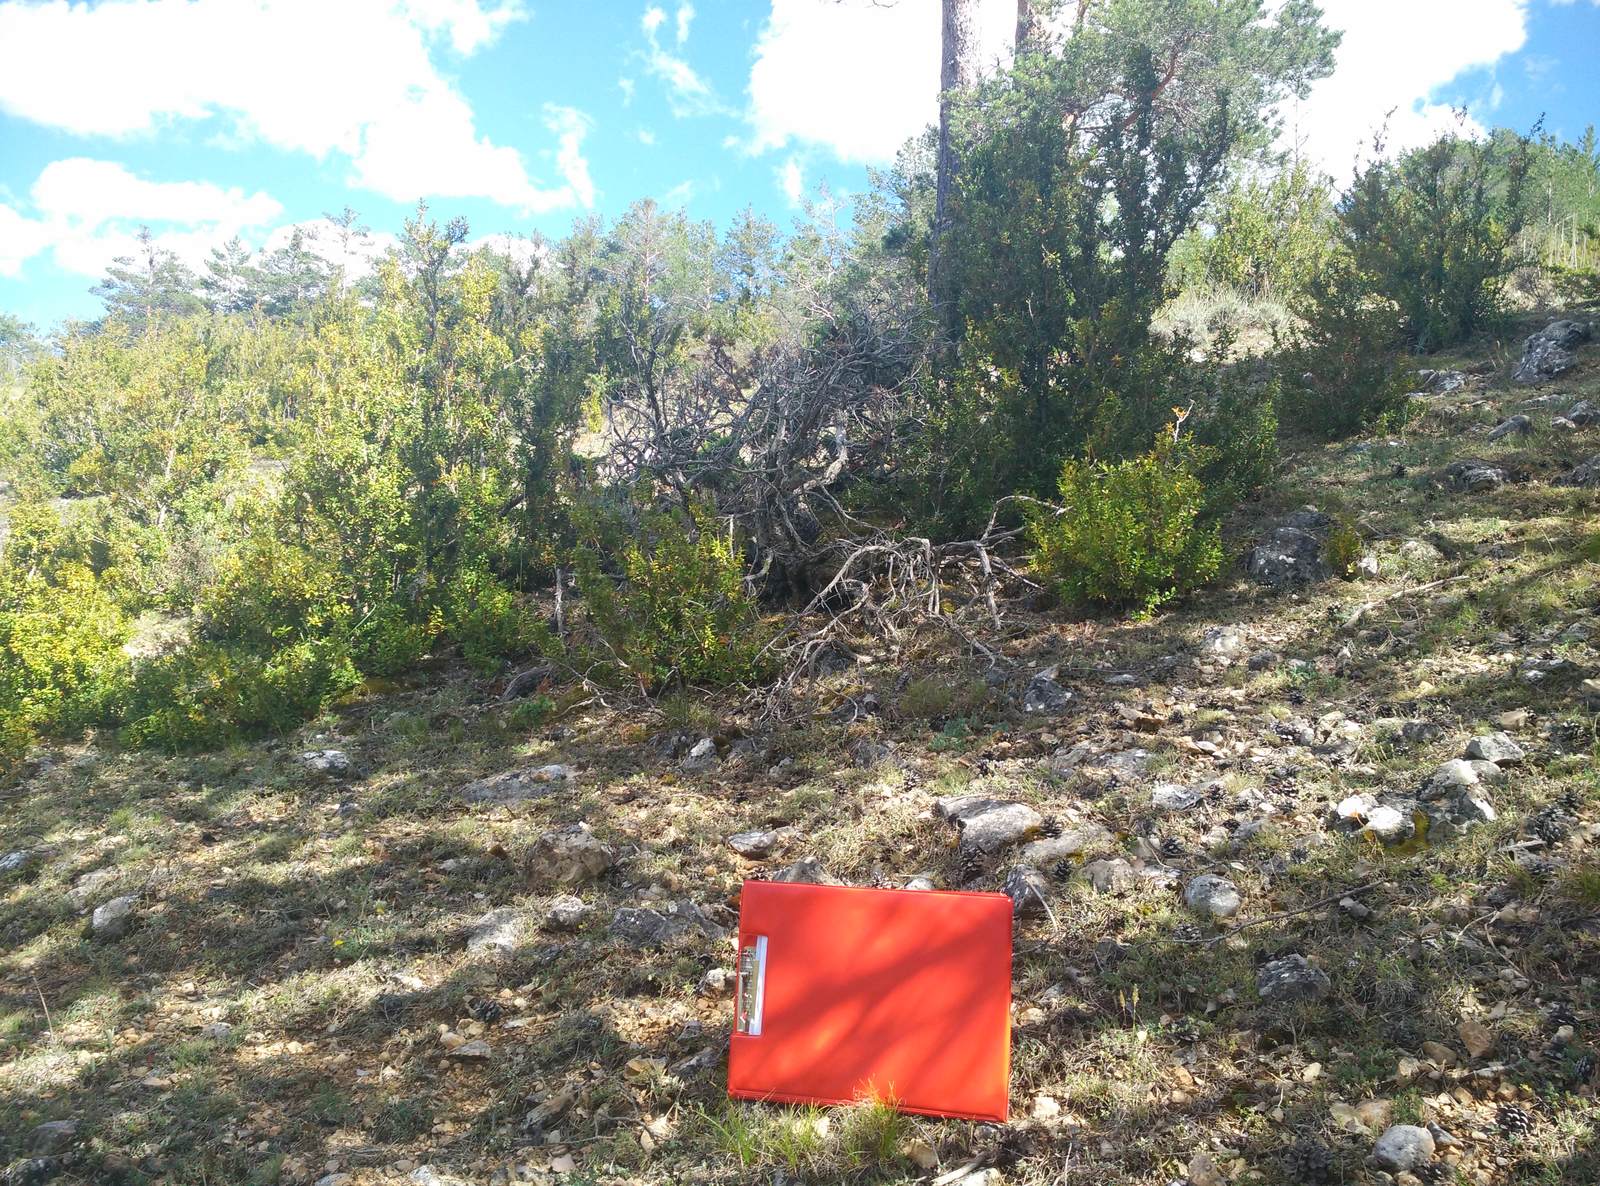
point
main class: Woodland
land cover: Pine dominated coniferous woodland
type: coniferous forest of the mediterranean region
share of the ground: 25 - 50 %
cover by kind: herbaceous plants 50 %, coniferous forest trees 25 %, shrubs 15 %, unconsolidated bare surface 10 %
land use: Semi-natural and natural areas not in use
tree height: > 5 m
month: June
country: ES
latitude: 40.6555
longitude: -1.7395
